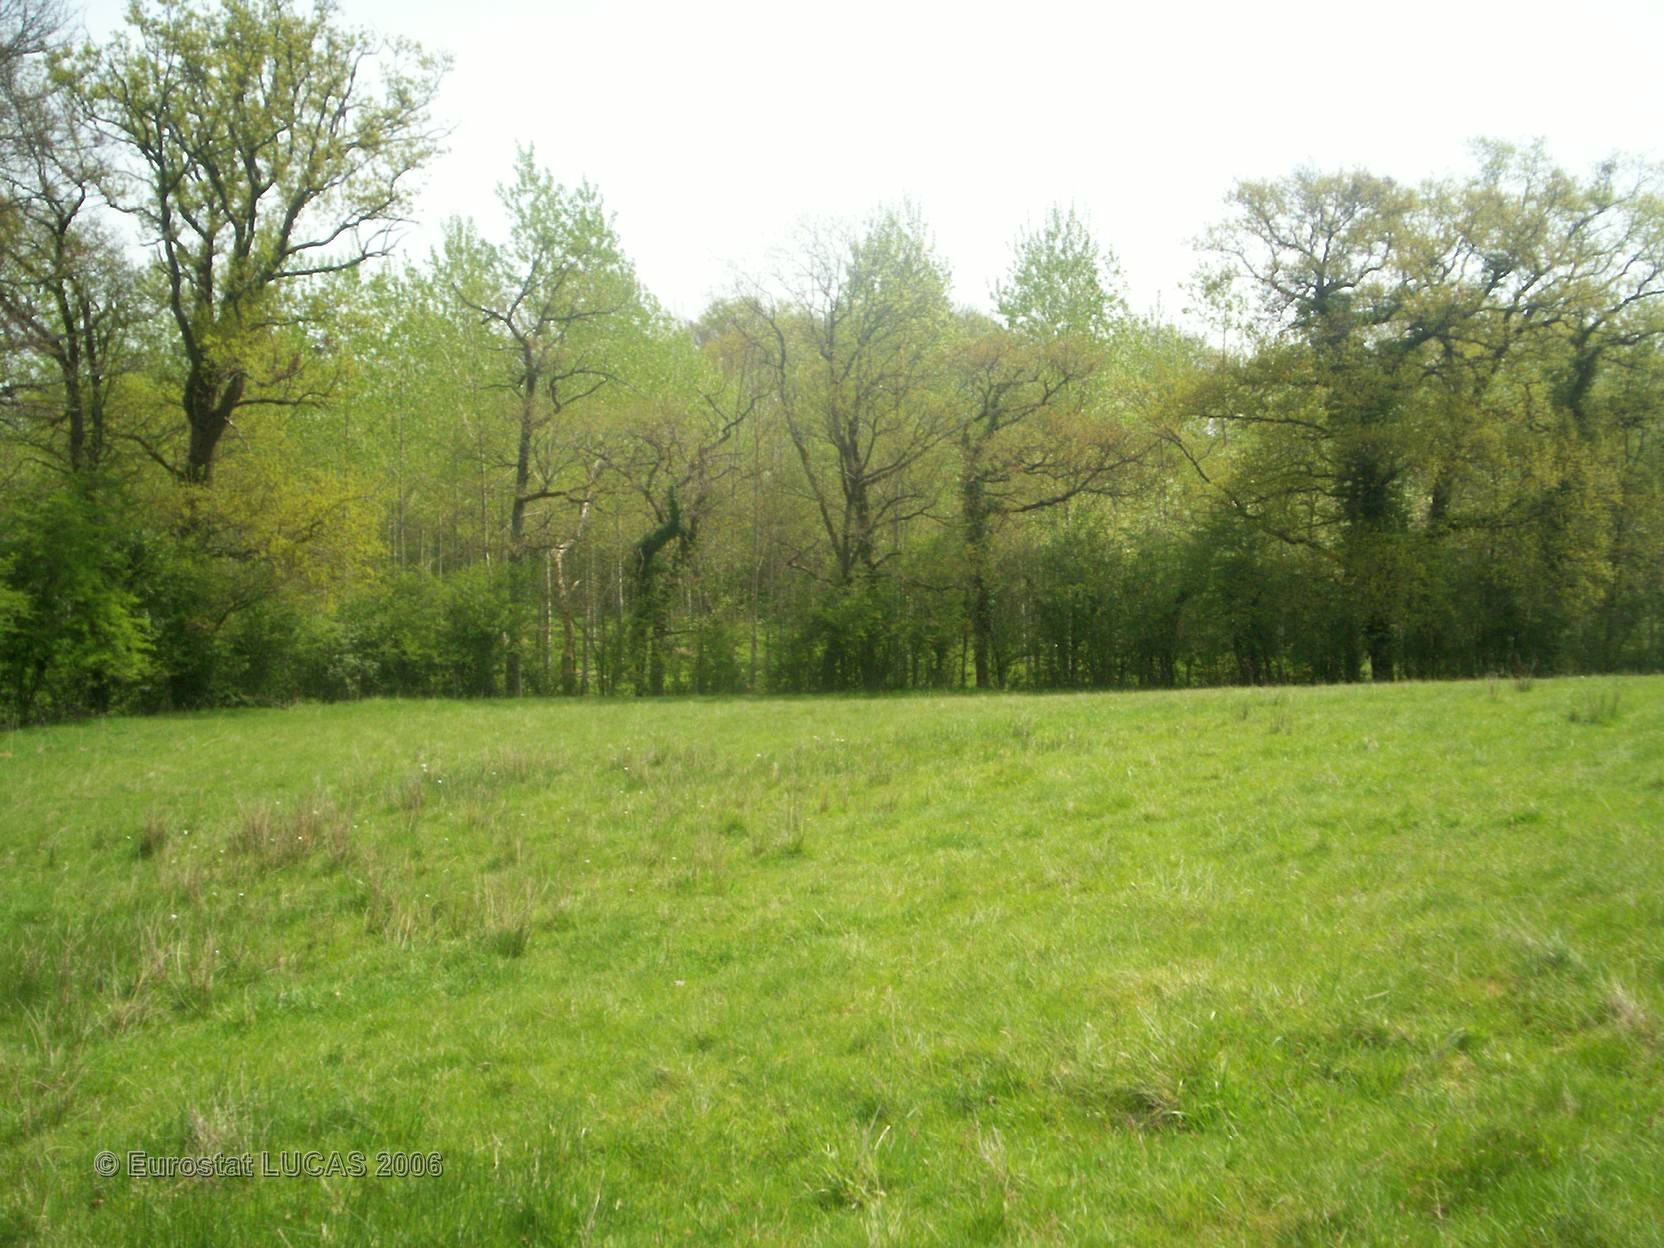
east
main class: Grassland
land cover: Grassland without tree/shrub cover
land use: Agriculture (excluding fallow land and kitchen gardens)
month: May
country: FR
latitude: 46.5064
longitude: 3.0775
